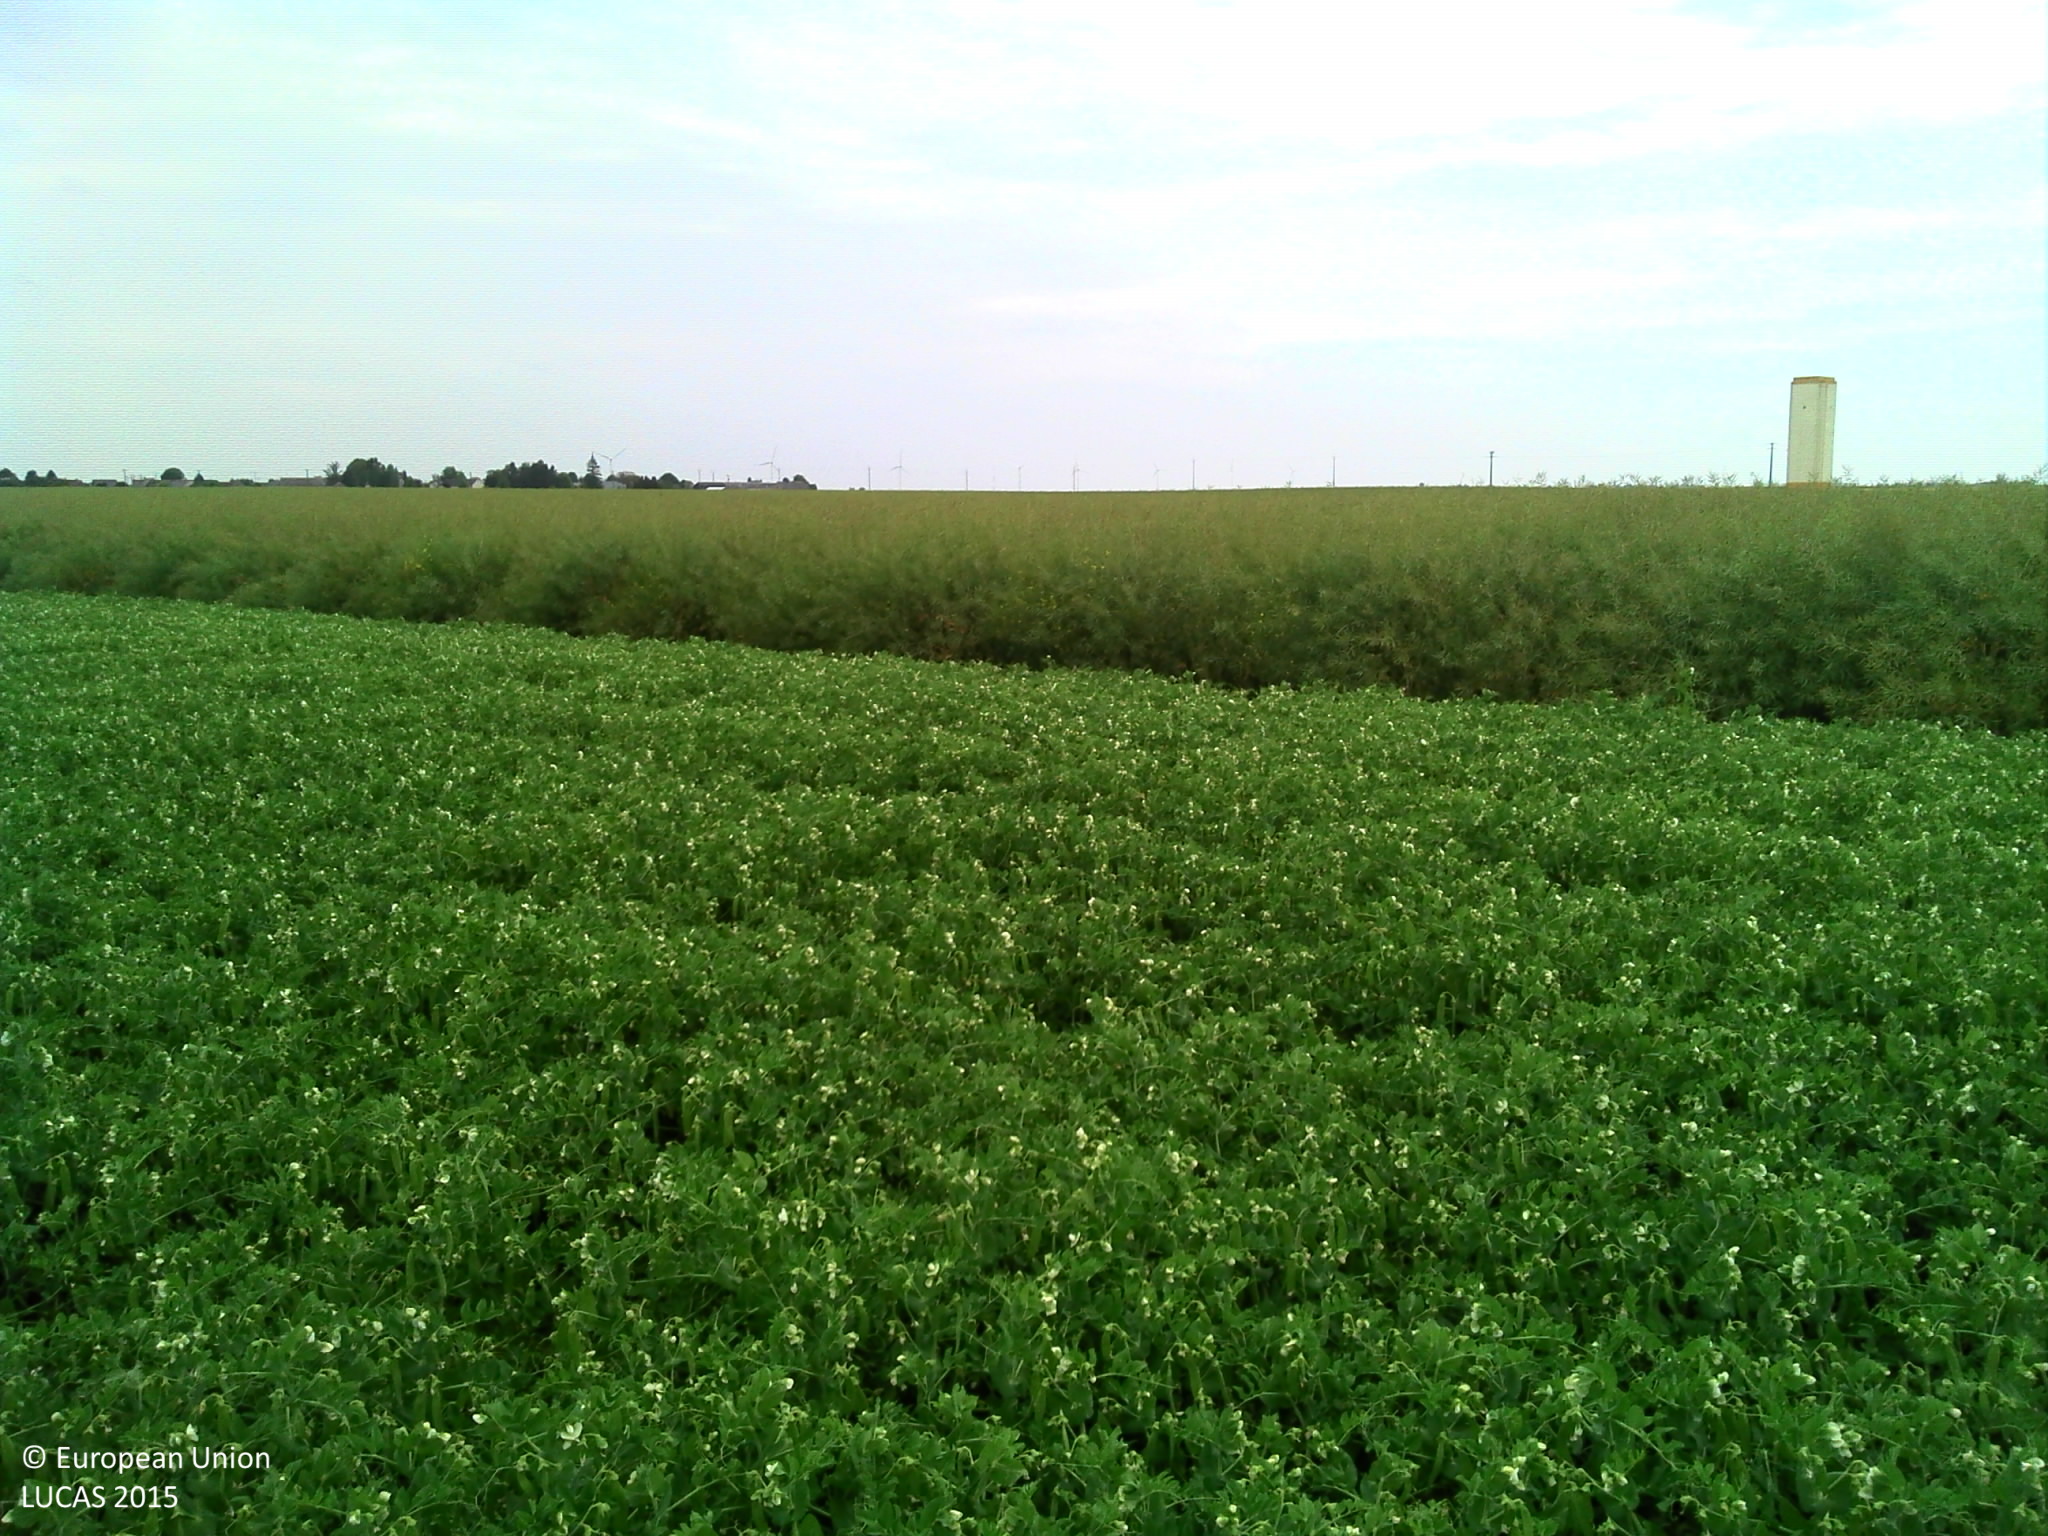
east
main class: Cropland
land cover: Dry pulses
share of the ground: > 75 %
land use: Agriculture (excluding fallow land and kitchen gardens)
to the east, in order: Dry pulses; Rape and turnip rape
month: June
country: FR
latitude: 48.2177
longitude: 1.4640
